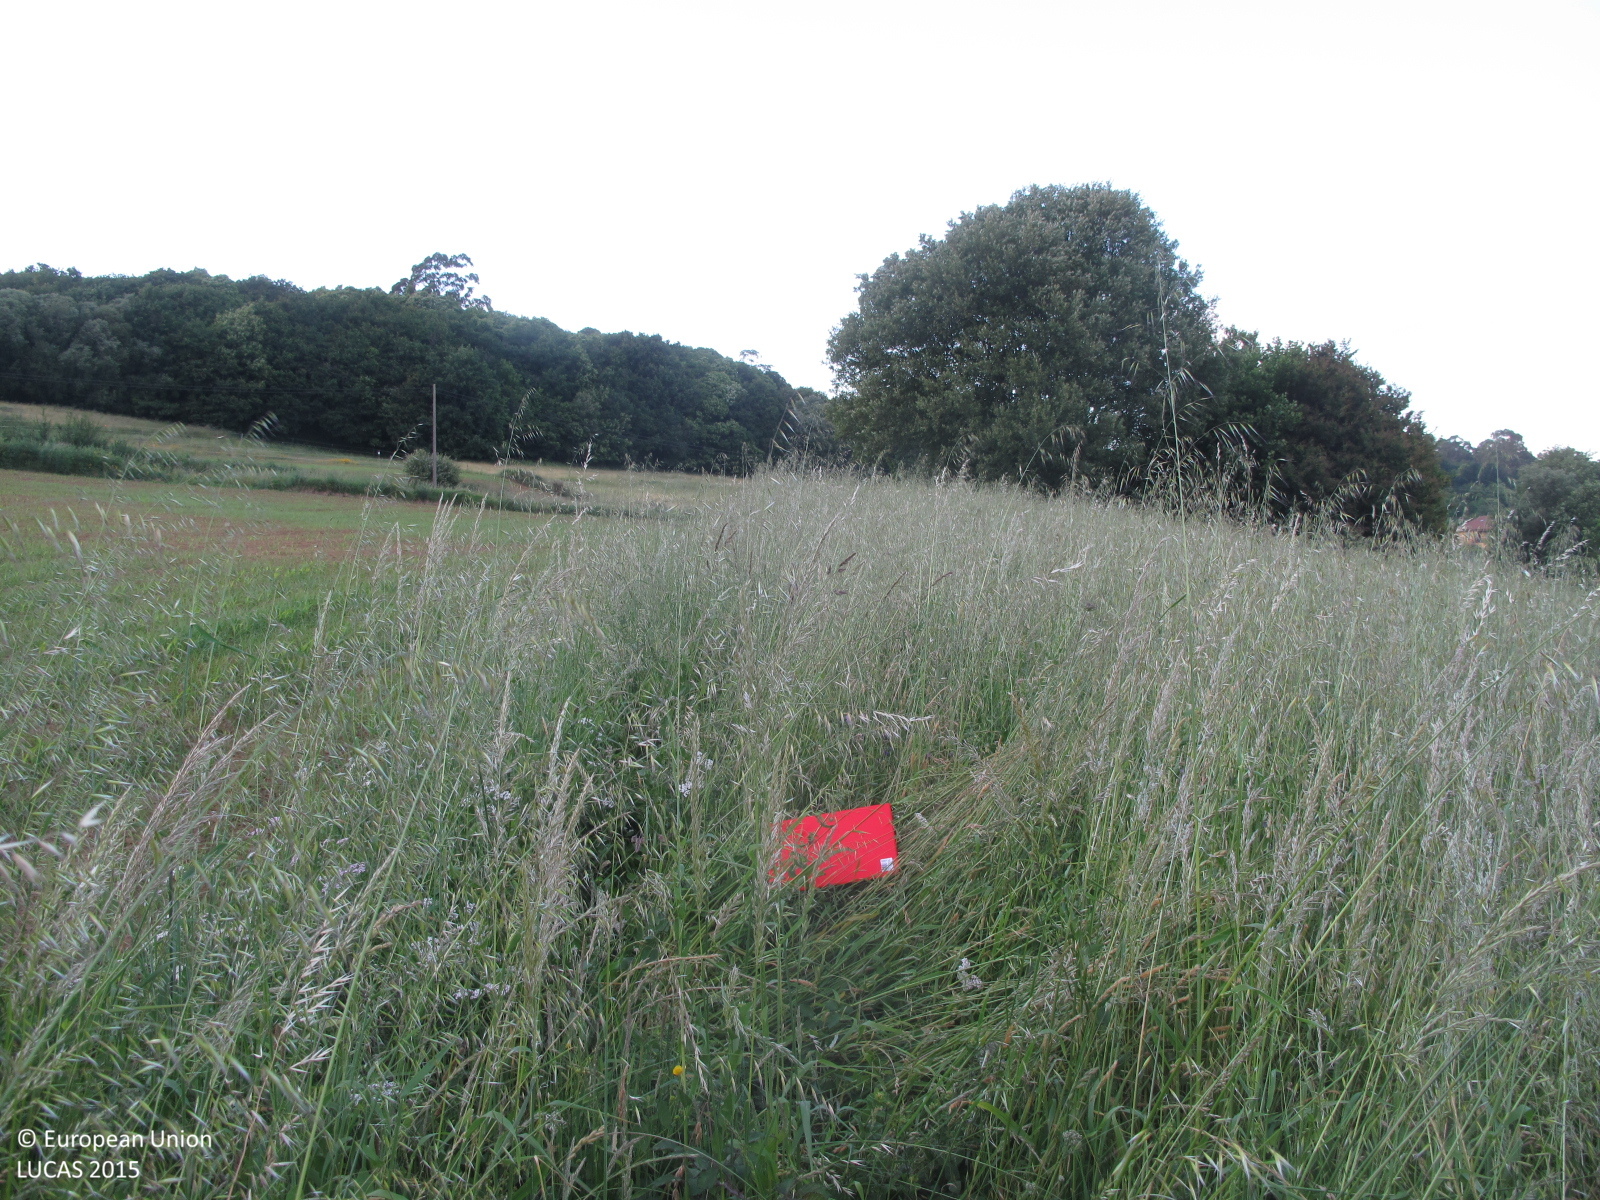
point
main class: Grassland
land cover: Grassland without tree/shrub cover
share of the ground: > 75 %
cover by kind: herbaceous plants 100 %
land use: Agriculture (excluding fallow land and kitchen gardens)
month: June
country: ES
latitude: 42.8719
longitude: -8.5021
